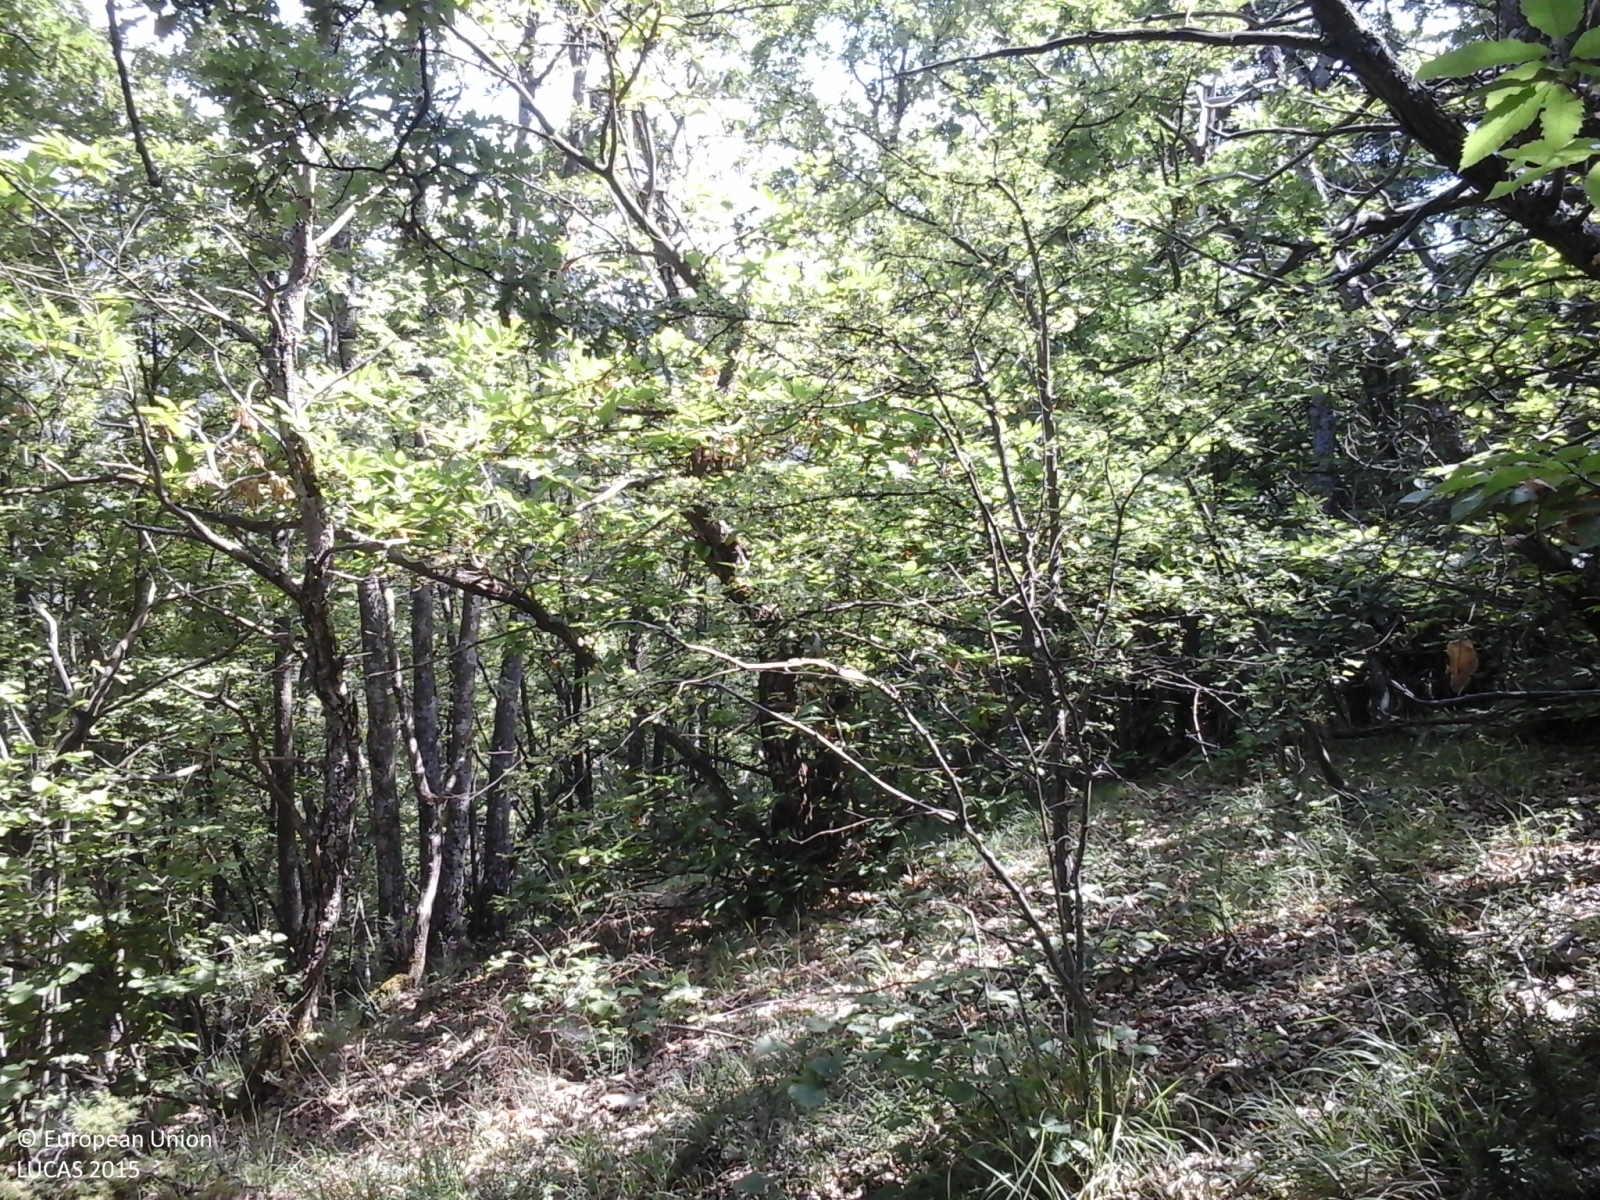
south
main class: Woodland
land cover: Broadleaved woodland
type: thermophilous deciduous forest
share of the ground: > 75 %
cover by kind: broadleaved forest trees 100 %
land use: Forestry
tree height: > 5 m
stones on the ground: 25 - 50 %
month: June
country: IT
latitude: 44.6533
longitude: 9.1066
